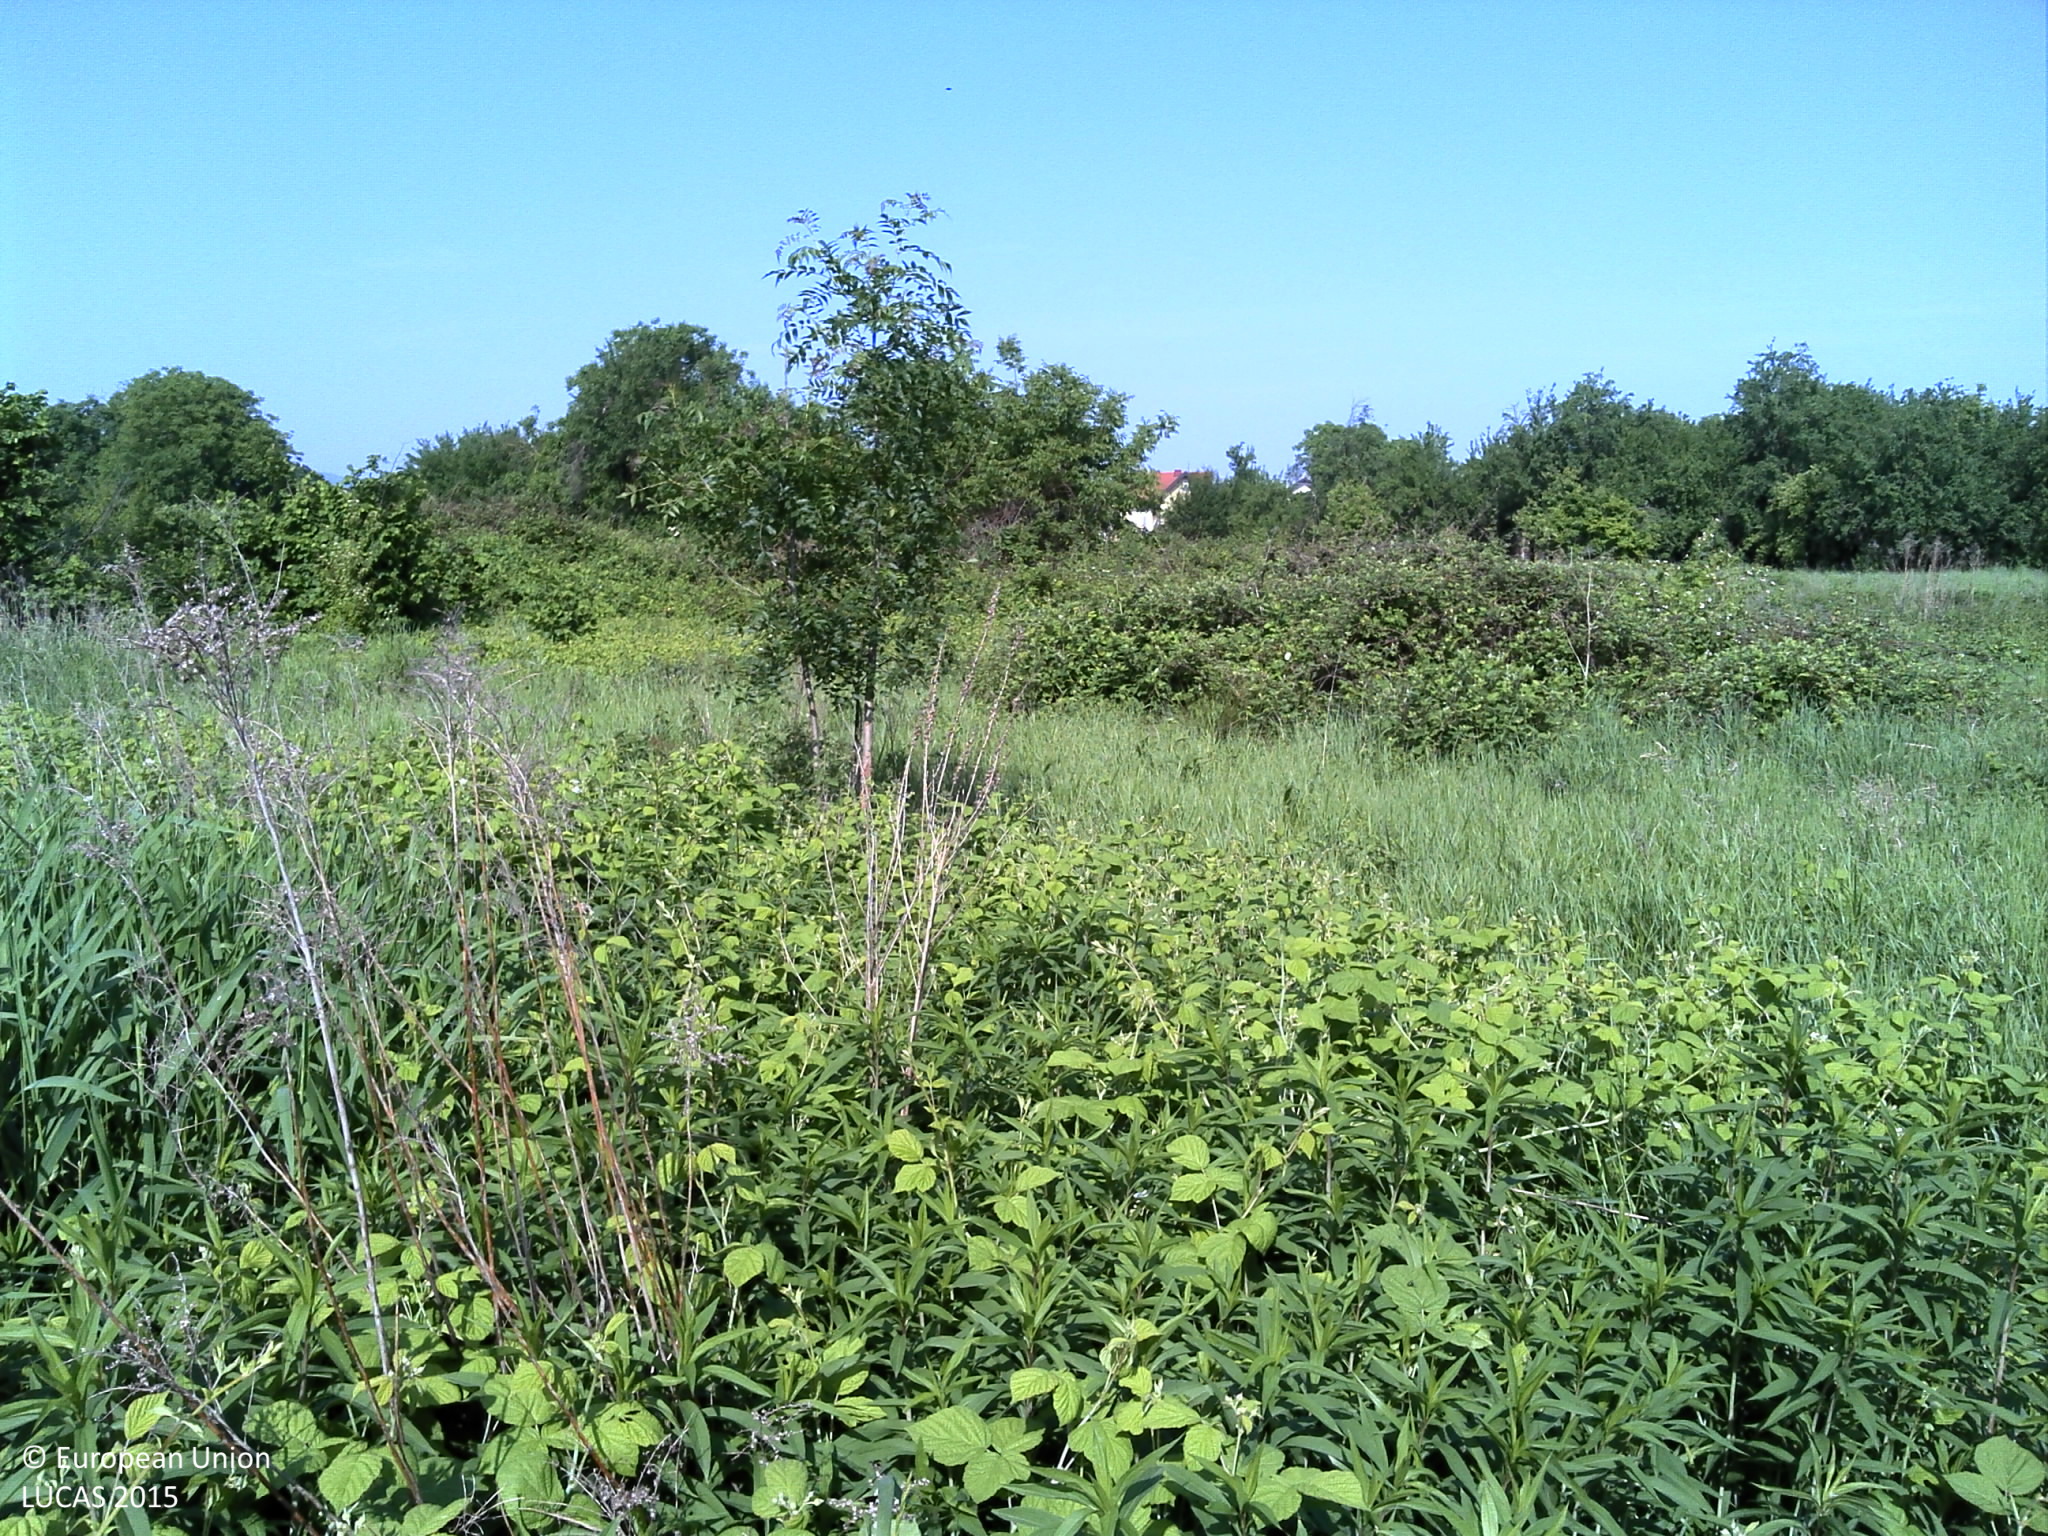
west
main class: Shrubland
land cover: Shrubland without tree cover
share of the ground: > 75 %
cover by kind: shrubs 100 %
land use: Semi-natural and natural areas not in use
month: May
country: HR
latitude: 45.5278
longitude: 17.9806
